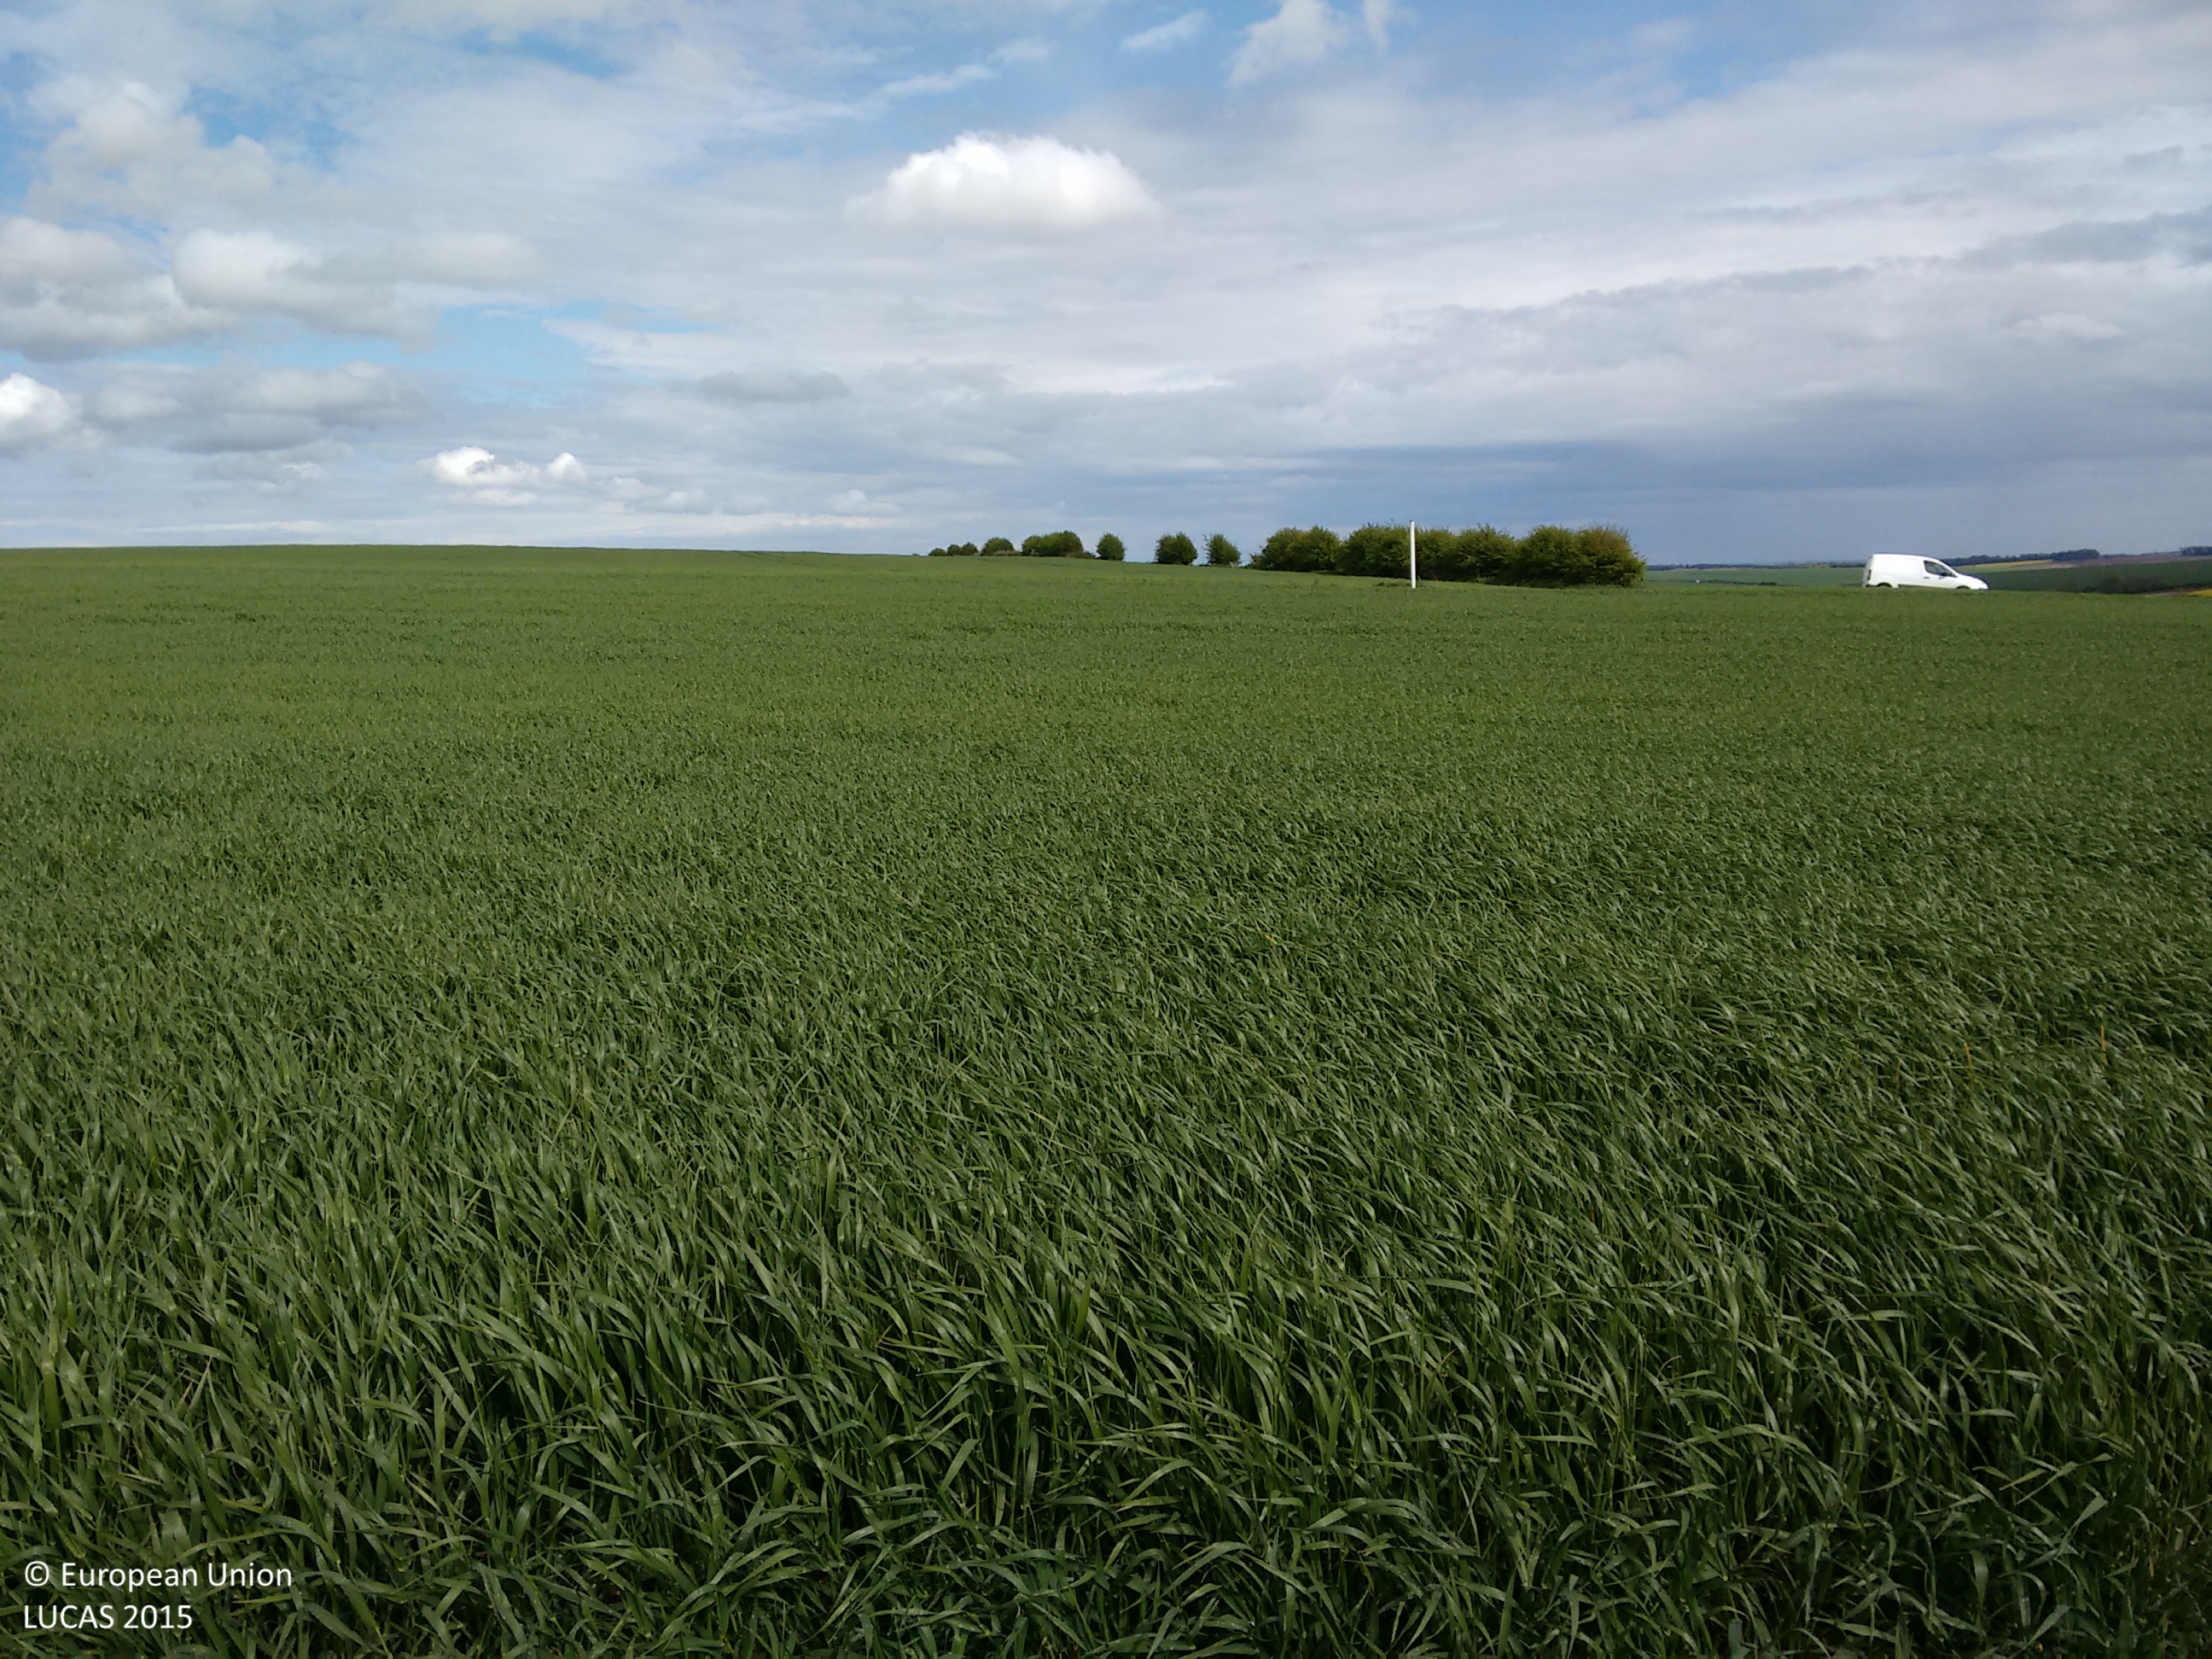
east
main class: Cropland
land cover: Barley
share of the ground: > 75 %
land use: Agriculture (excluding fallow land and kitchen gardens)
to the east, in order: Barley; Grass margins; Tracks; Grass margins; Barley; Grass margins; Managed hedges; Grass margins; Tracks; Barley
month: May
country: GB
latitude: 53.3121
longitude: -0.0131
